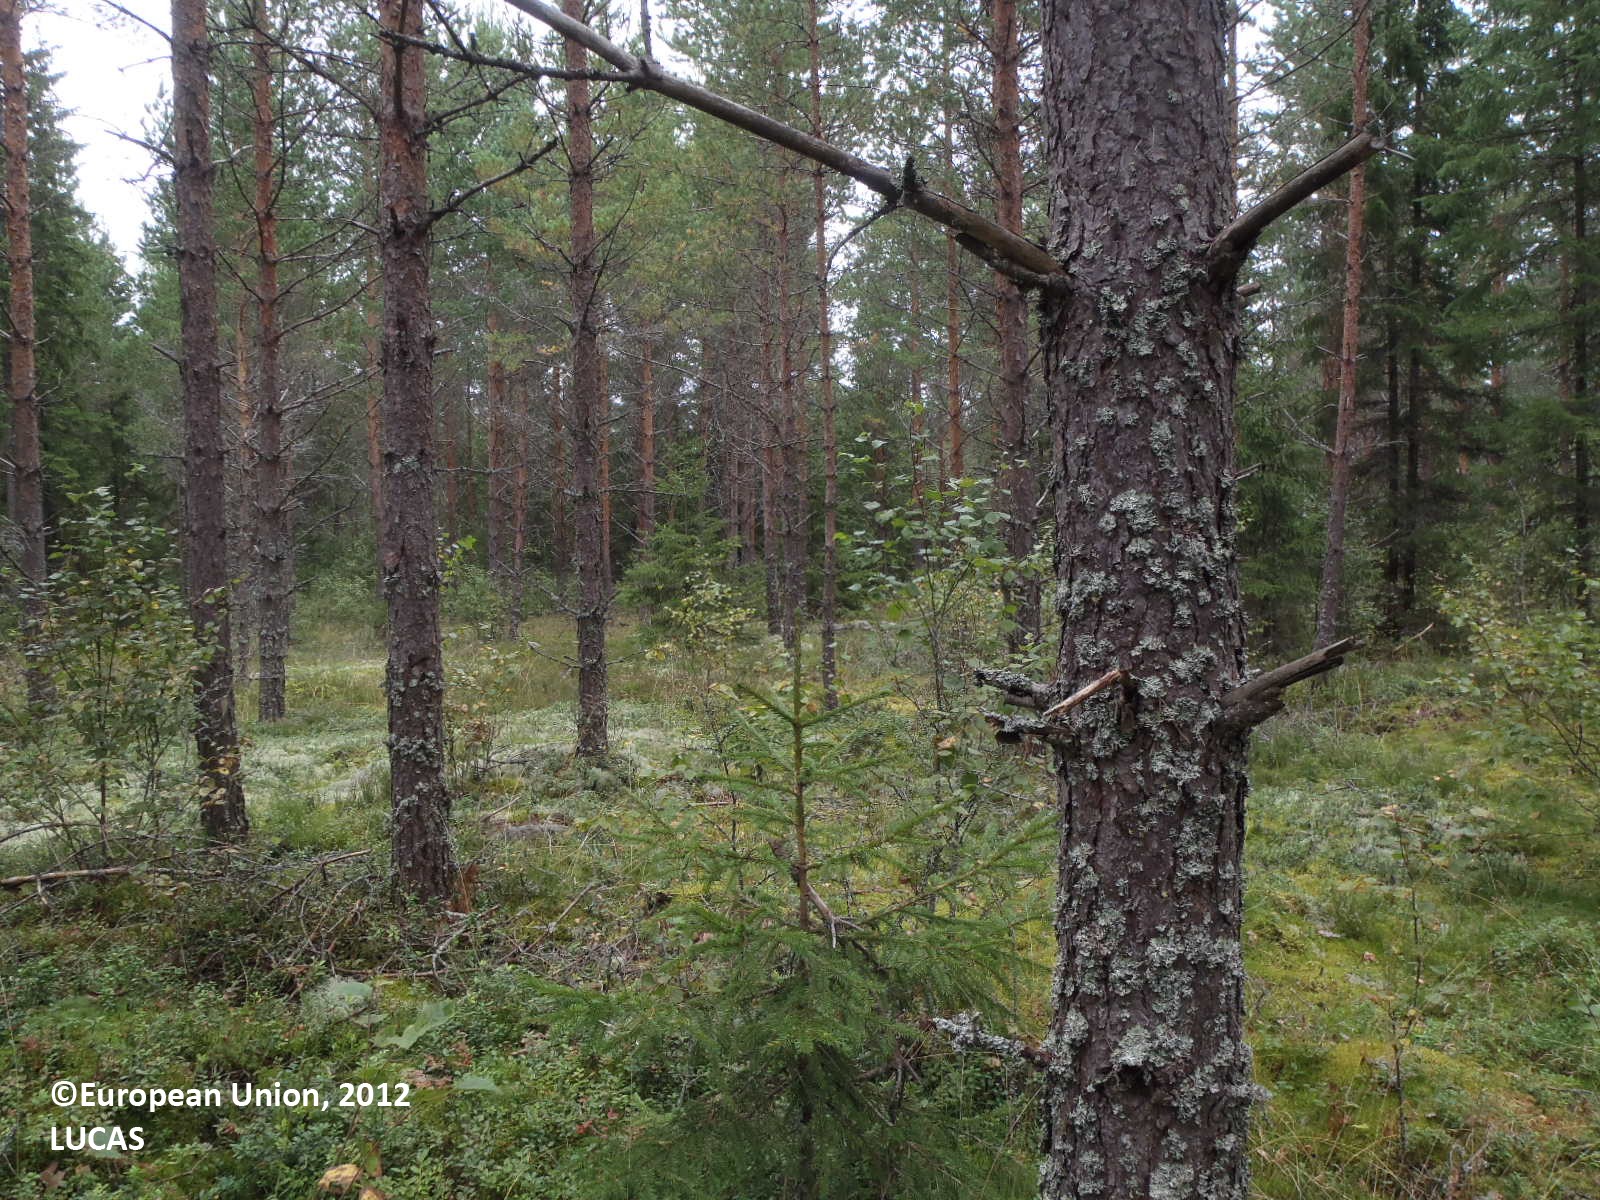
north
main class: Woodland
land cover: Pine dominated coniferous woodland
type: boreal forest
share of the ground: > 75 %
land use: Forestry
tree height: > 5 m
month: August
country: FI
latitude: 60.9138
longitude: 21.9169
